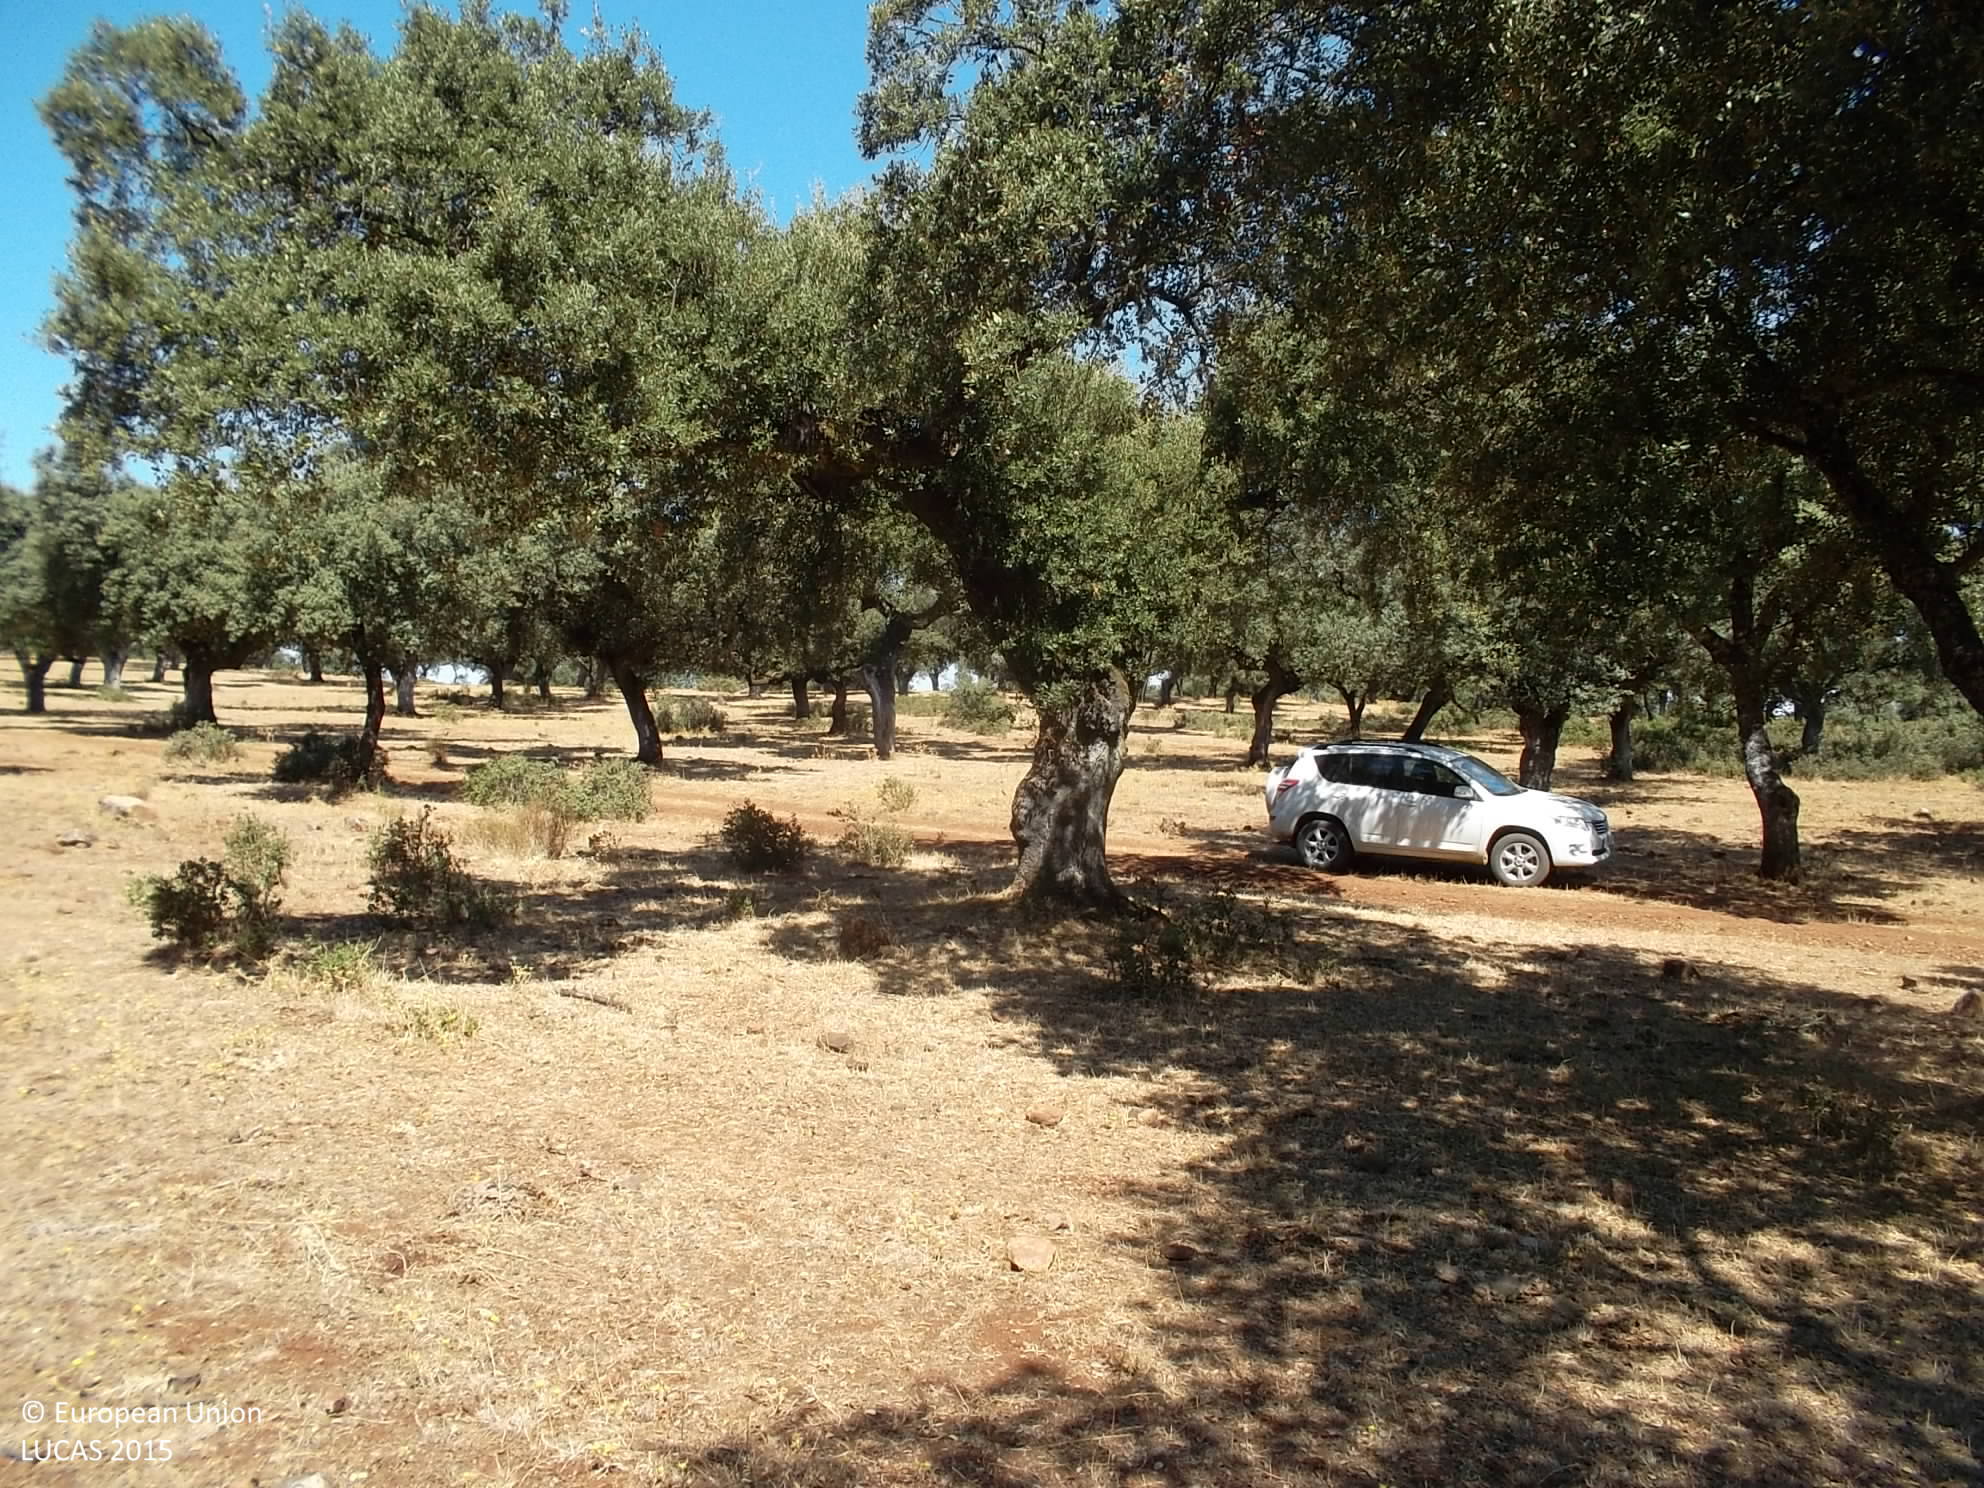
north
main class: Woodland
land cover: Broadleaved woodland
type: broadleaved evergreen forest
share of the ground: 50 - 75 %
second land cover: Grassland without tree/shrub cover
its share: 50 - 75 %
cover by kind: broadleaved forest trees 50 %, herbaceous plants 50 %
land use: Forestry
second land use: Agriculture (excluding fallow land and kitchen gardens)
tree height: > 5 m
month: August
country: ES
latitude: 38.2388
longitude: -6.6756
